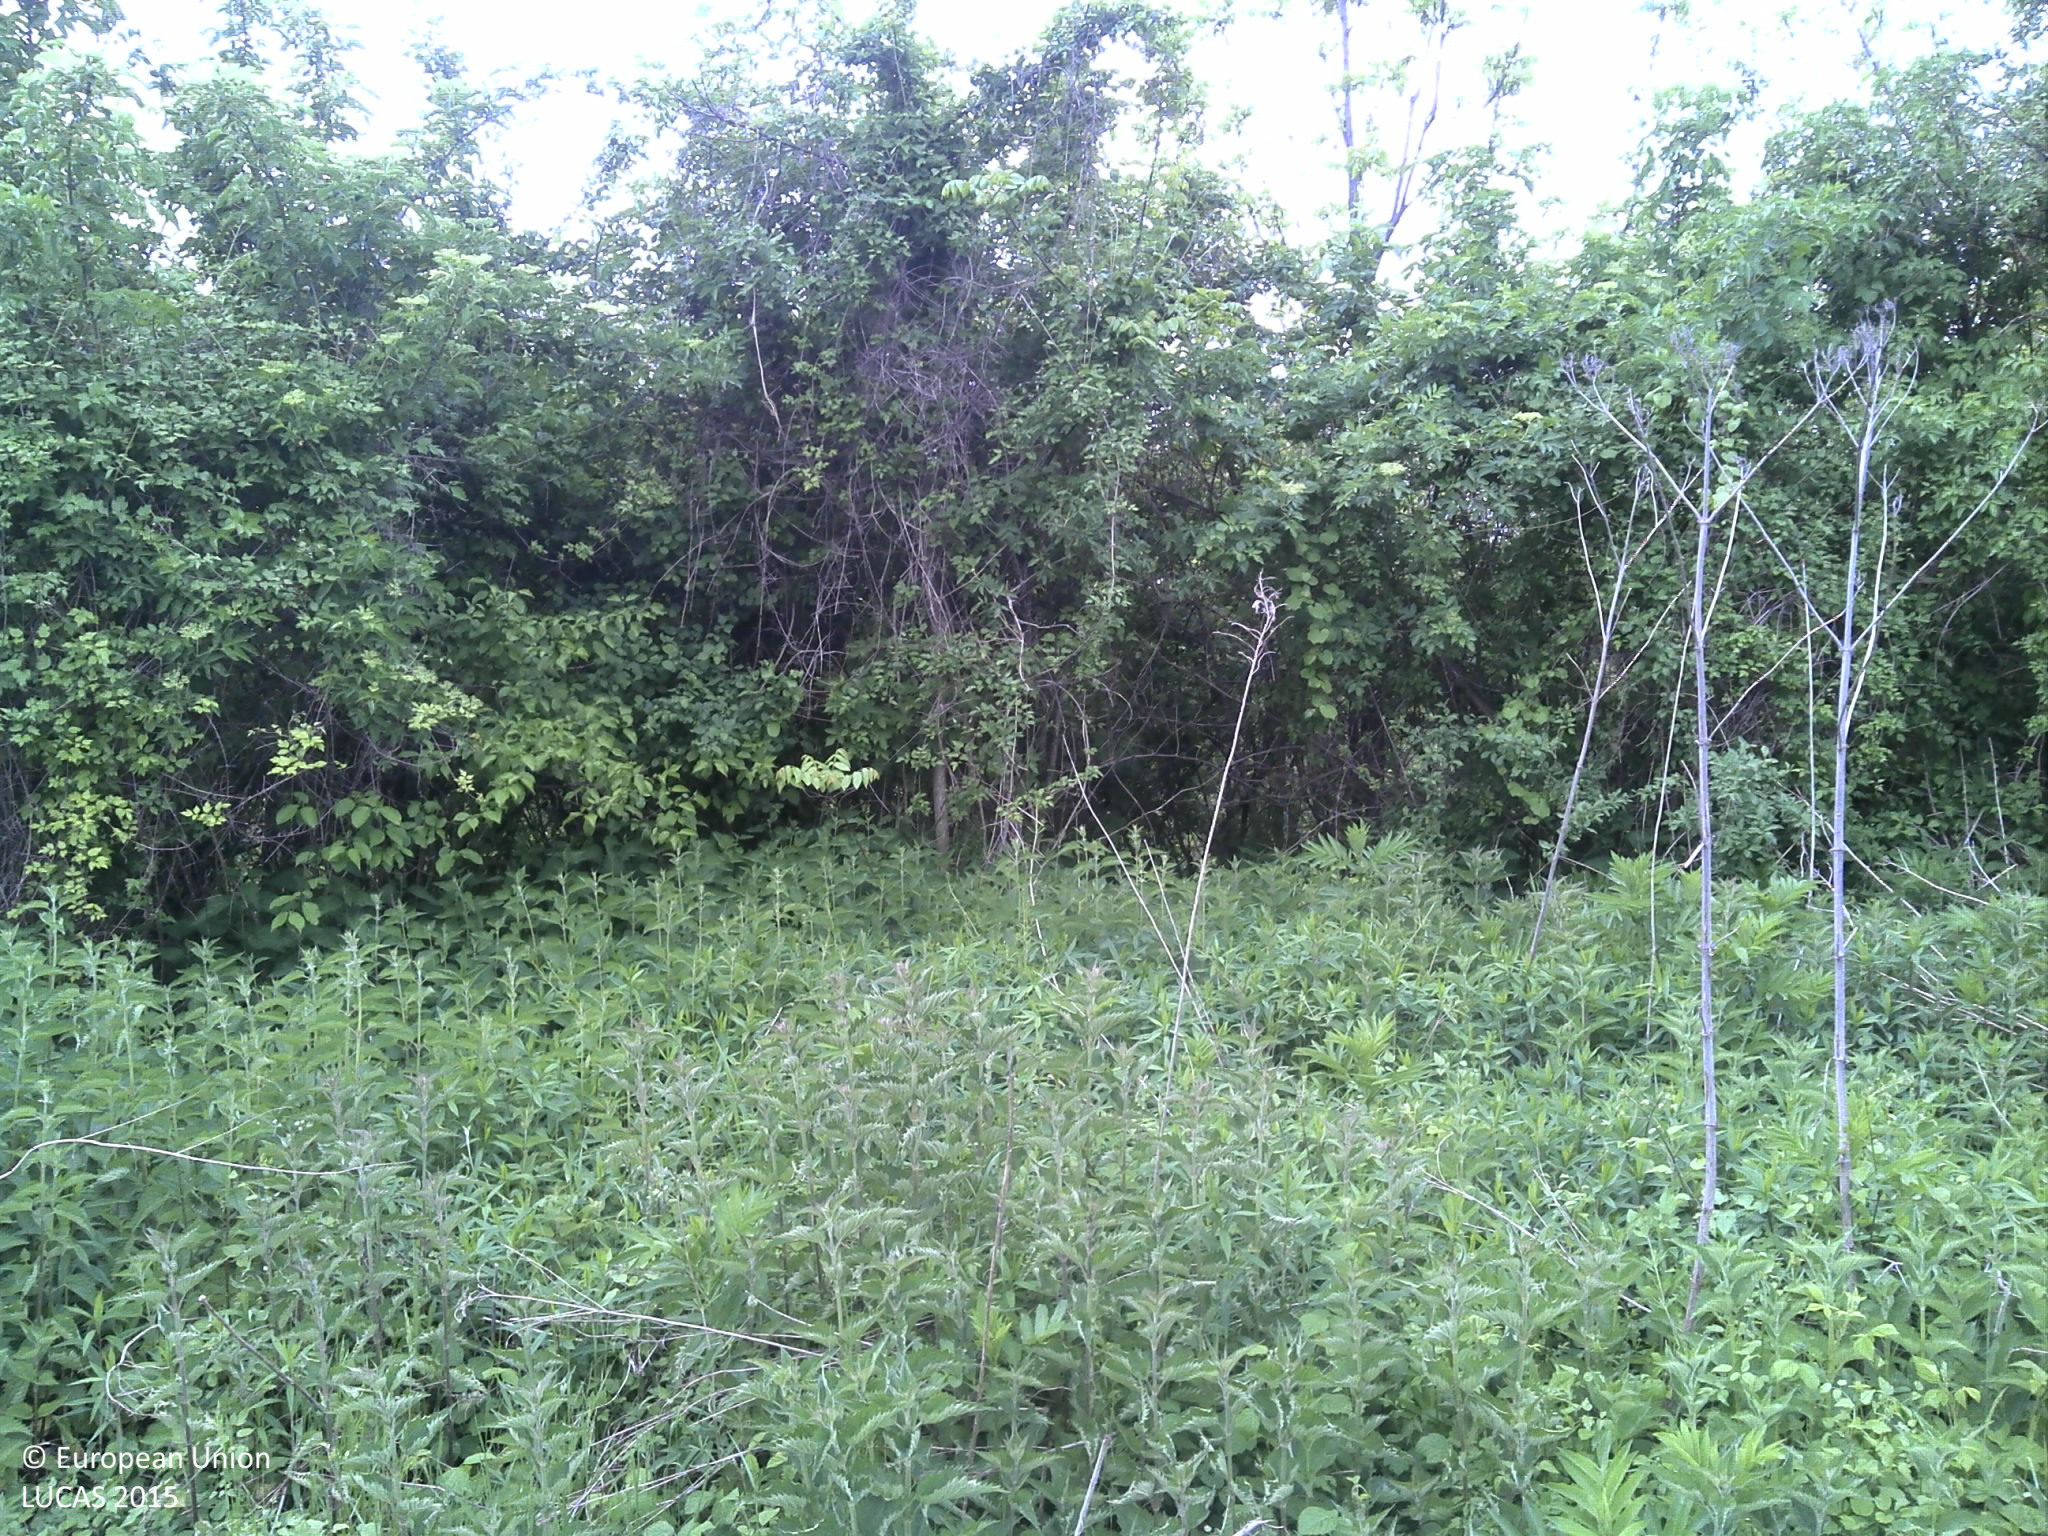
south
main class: Cropland
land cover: Common wheat
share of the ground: > 75 %
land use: Agriculture (excluding fallow land and kitchen gardens)
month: May
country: HR
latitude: 45.2340
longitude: 19.1422
